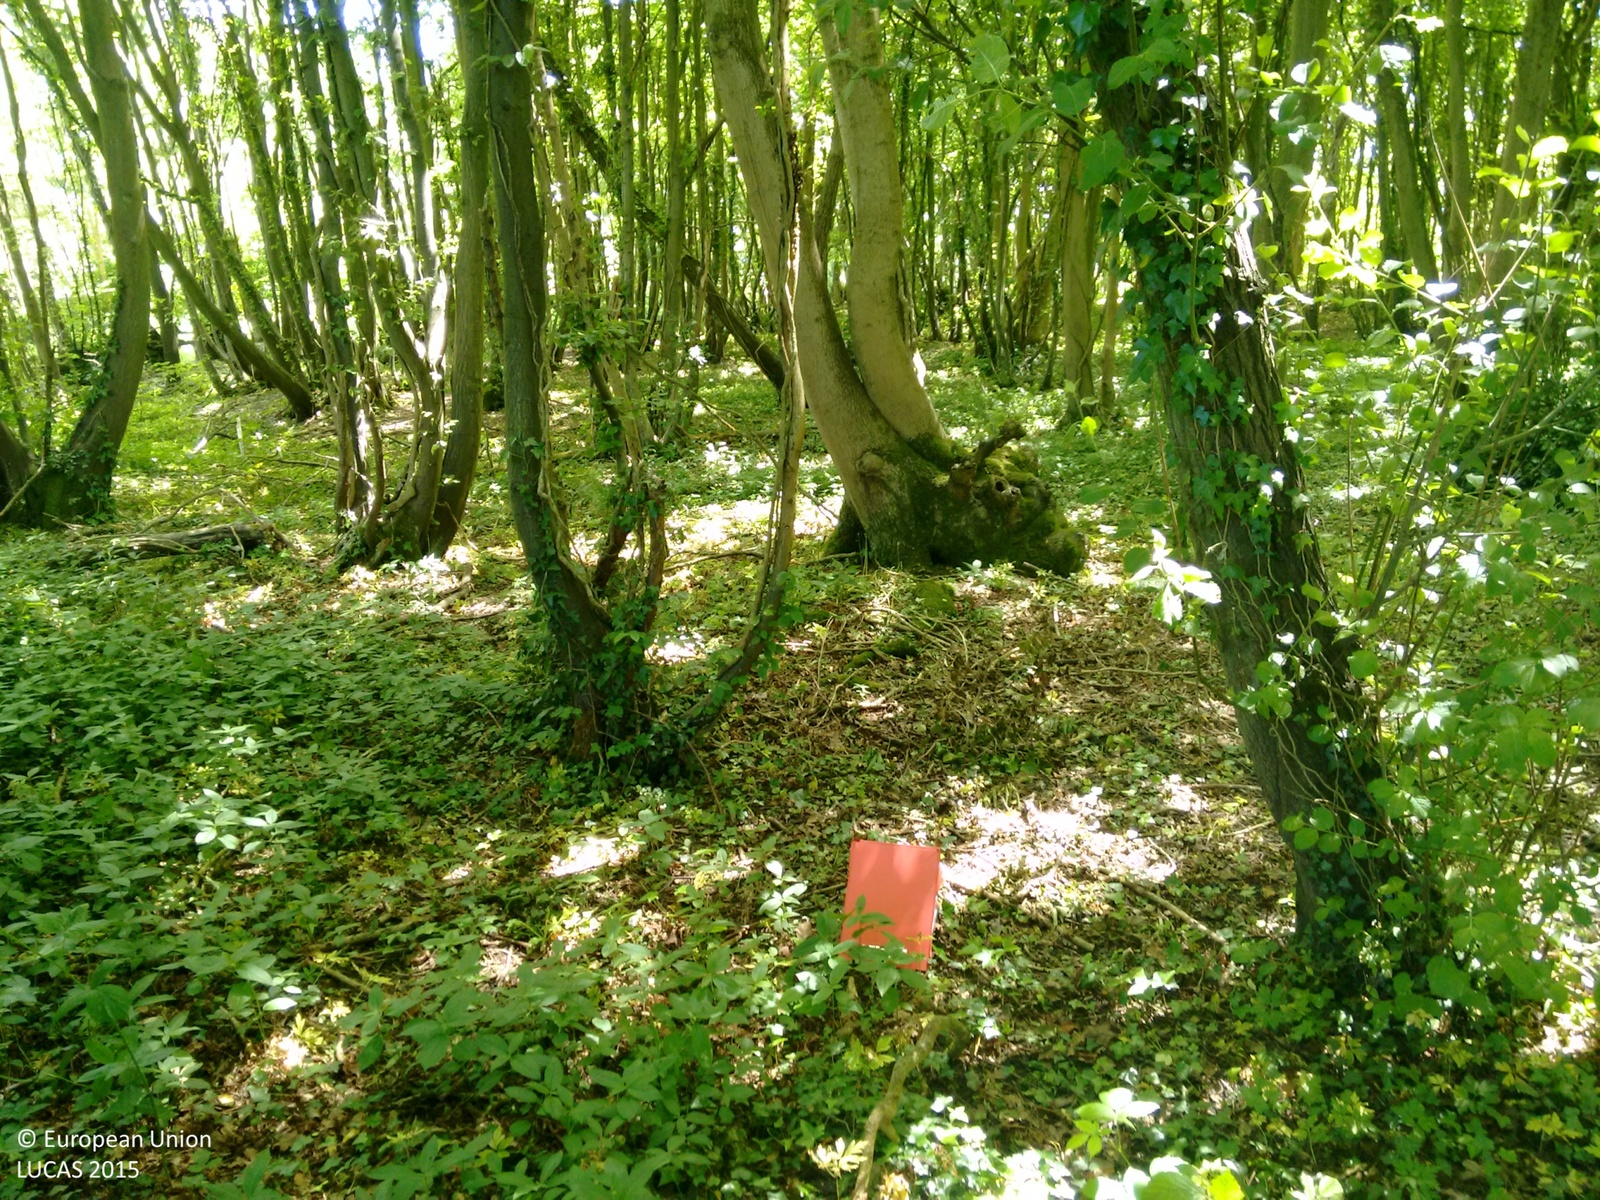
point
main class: Woodland
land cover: Broadleaved woodland
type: mesophytic deciduous forest
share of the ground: > 75 %
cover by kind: broadleaved forest trees 100 %
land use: Semi-natural and natural areas not in use
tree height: > 5 m
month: June
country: GB
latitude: 50.9376
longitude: 0.6238
